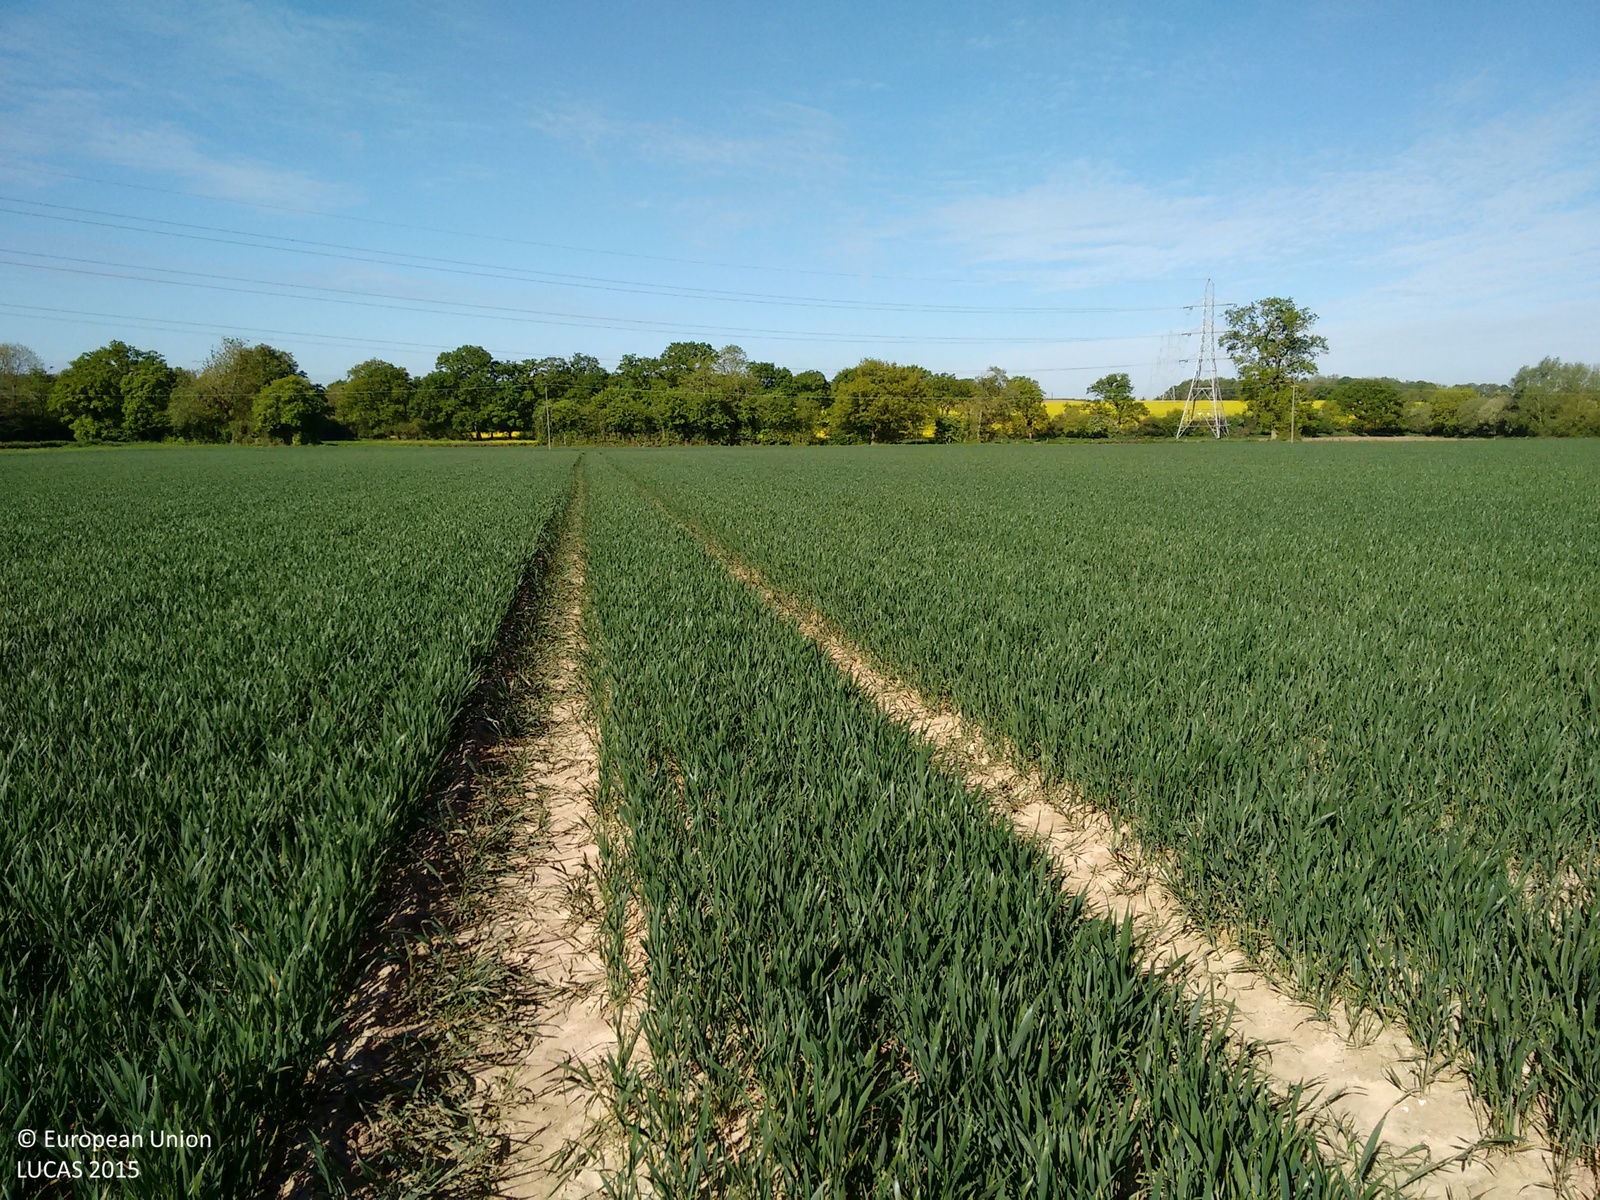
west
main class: Cropland
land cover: Common wheat
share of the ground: 50 - 75 %
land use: Agriculture (excluding fallow land and kitchen gardens)
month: May
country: GB
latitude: 51.2826
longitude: -1.0126
